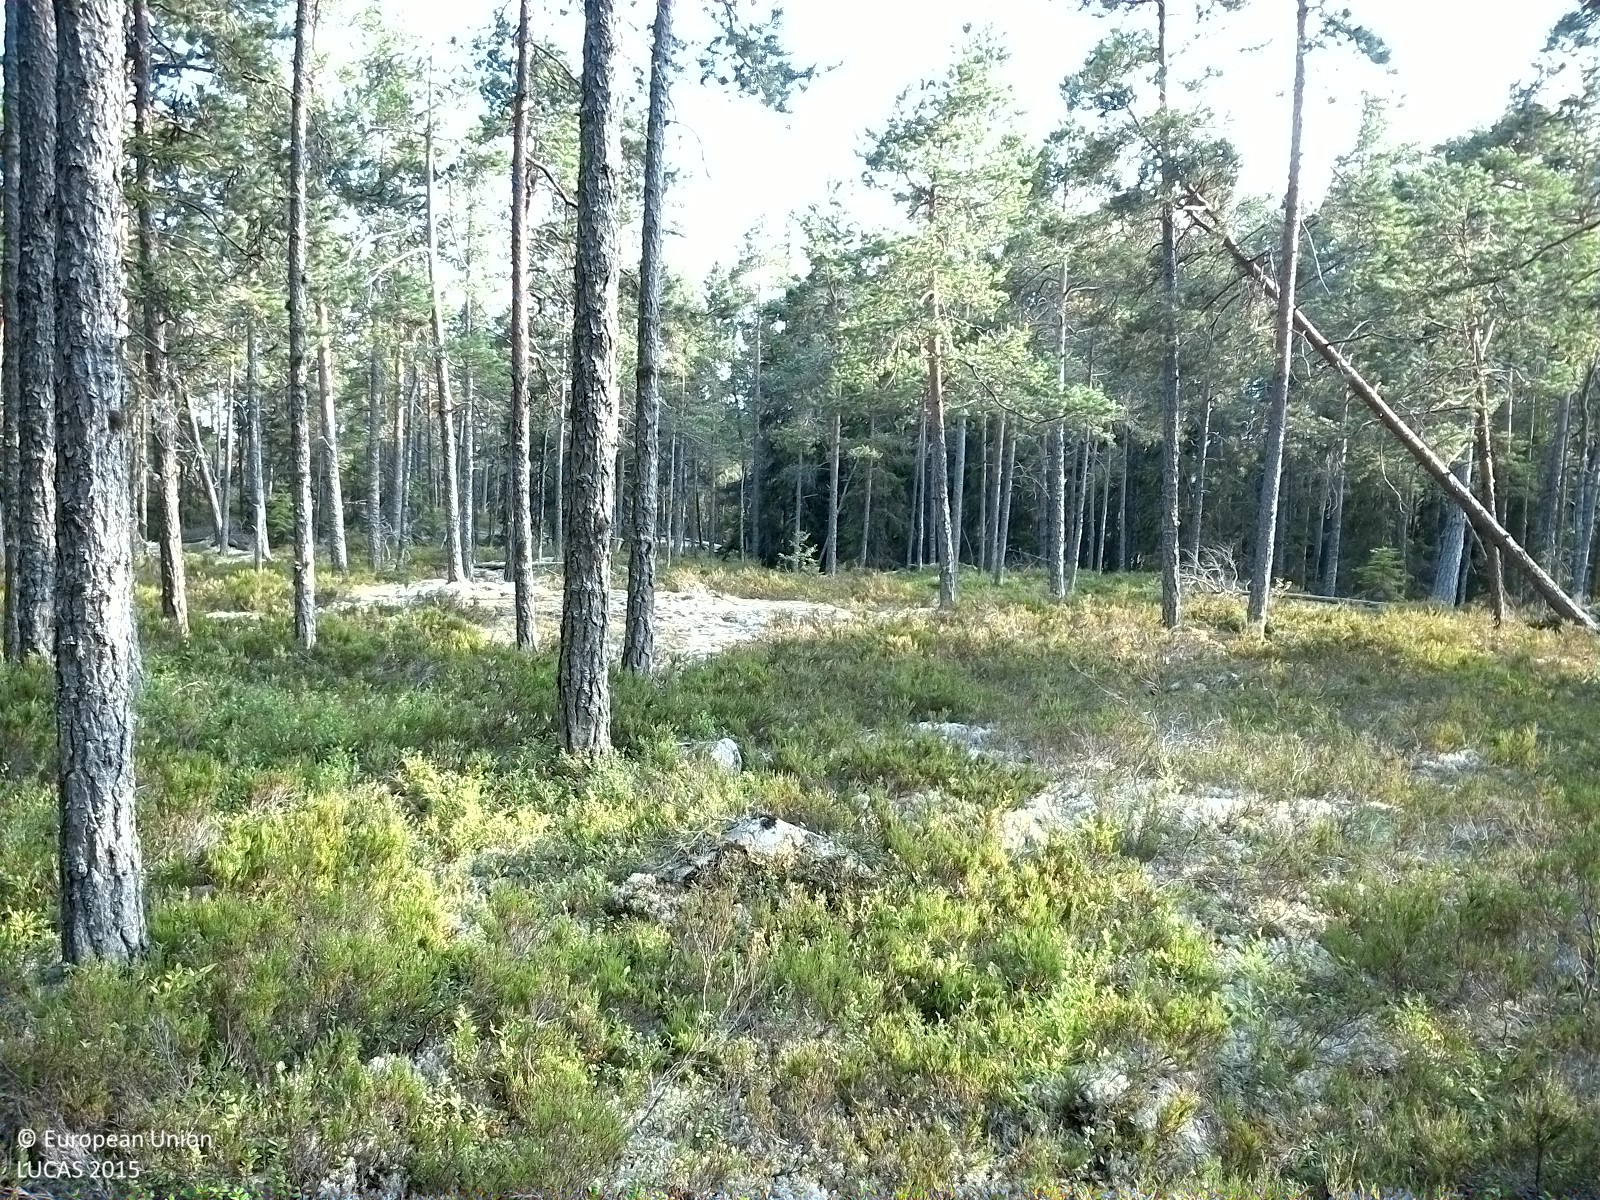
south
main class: Woodland
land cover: Pine dominated coniferous woodland
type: boreal forest
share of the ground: 25 - 50 %
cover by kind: lichens and mosses 40 %, coniferous forest trees 35 %, shrubs 25 %
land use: Forestry
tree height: > 5 m
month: August
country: SE
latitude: 62.3710
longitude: 17.5000
